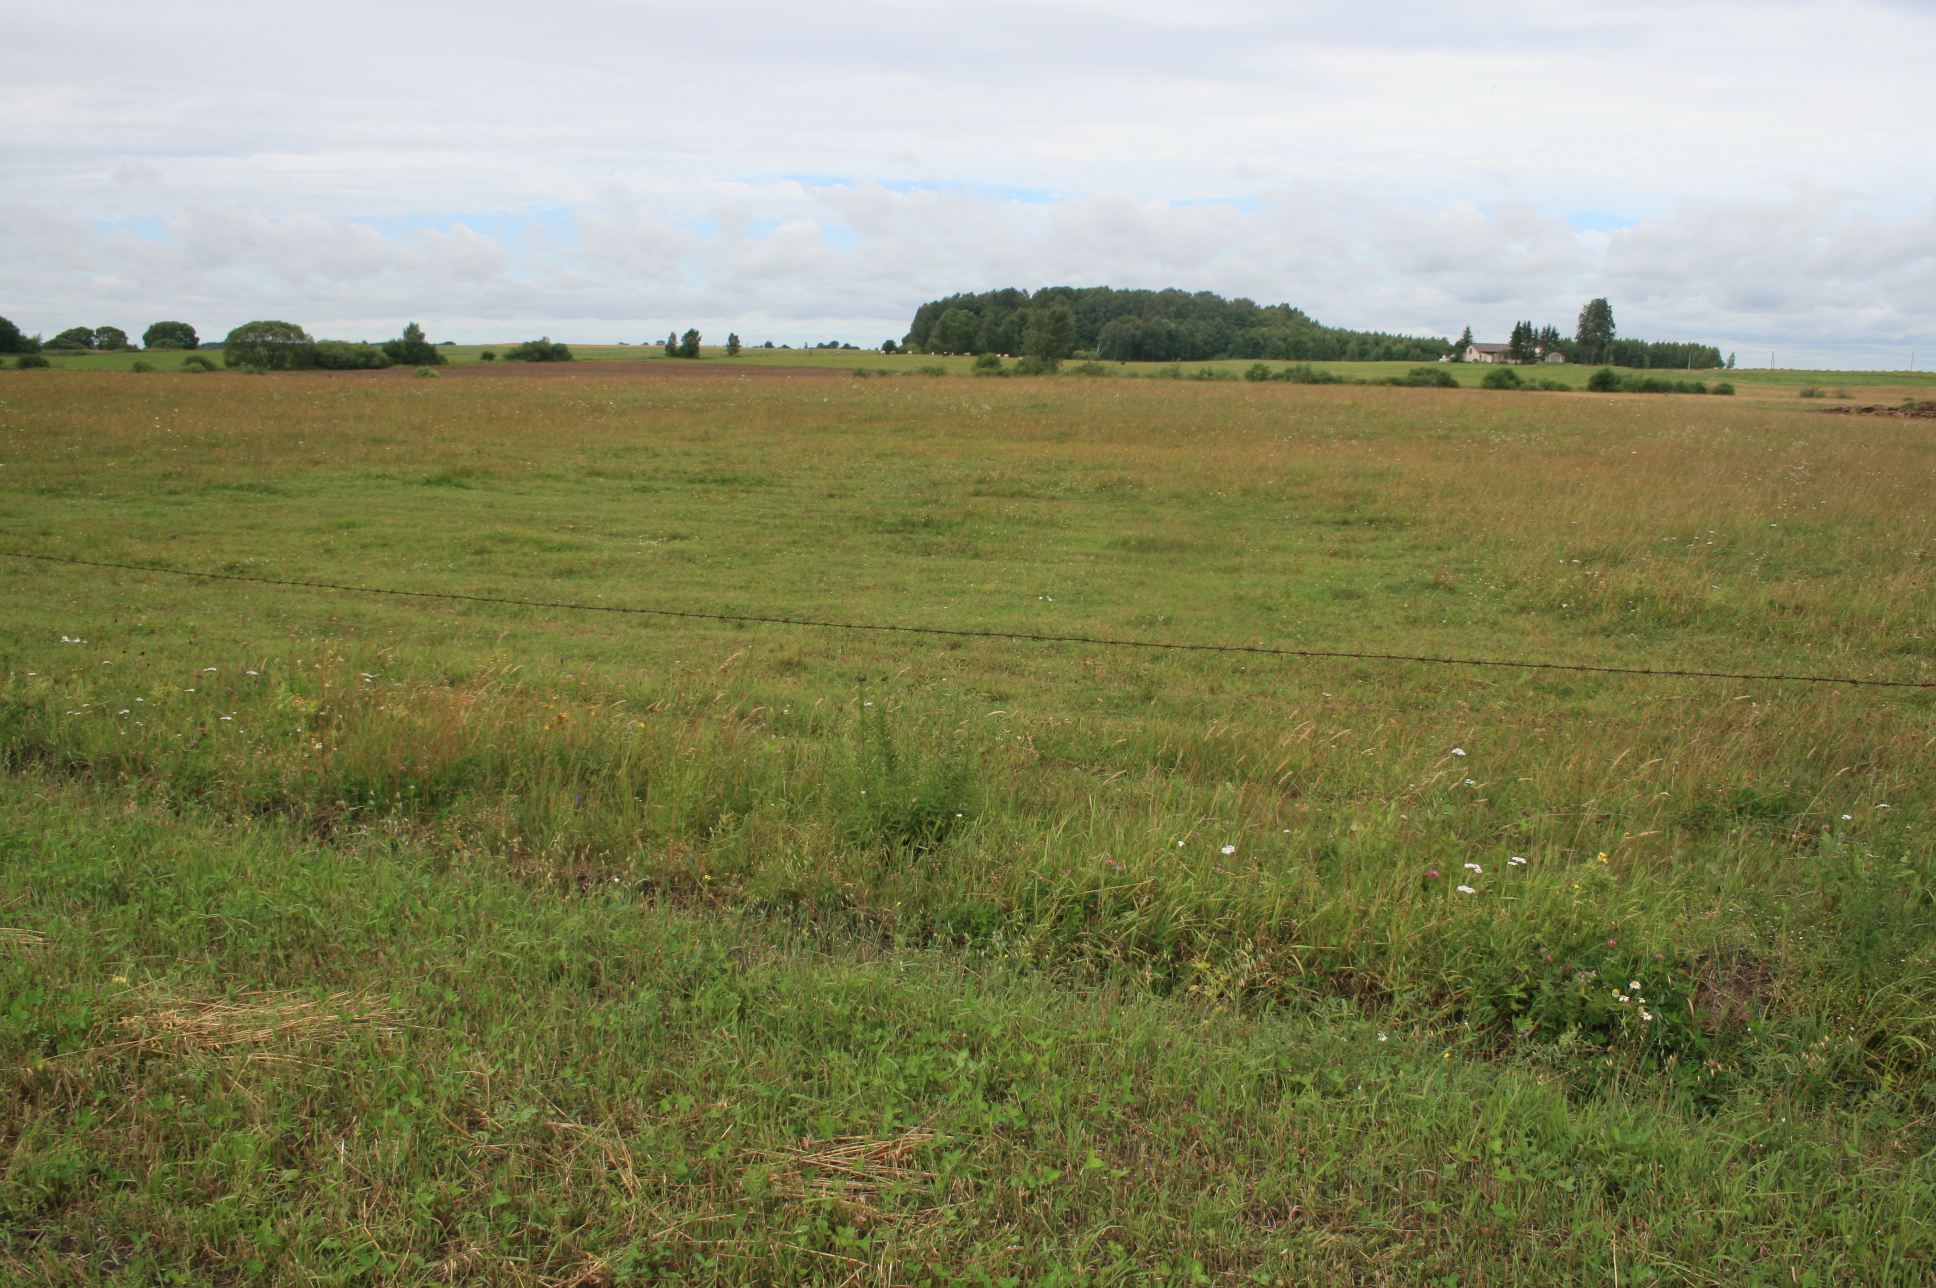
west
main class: Cropland
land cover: Other leguminous and mixtures for fodder
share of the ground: > 75 %
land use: Agriculture (excluding fallow land and kitchen gardens)
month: July
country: LT
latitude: 55.2940
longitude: 22.0069
